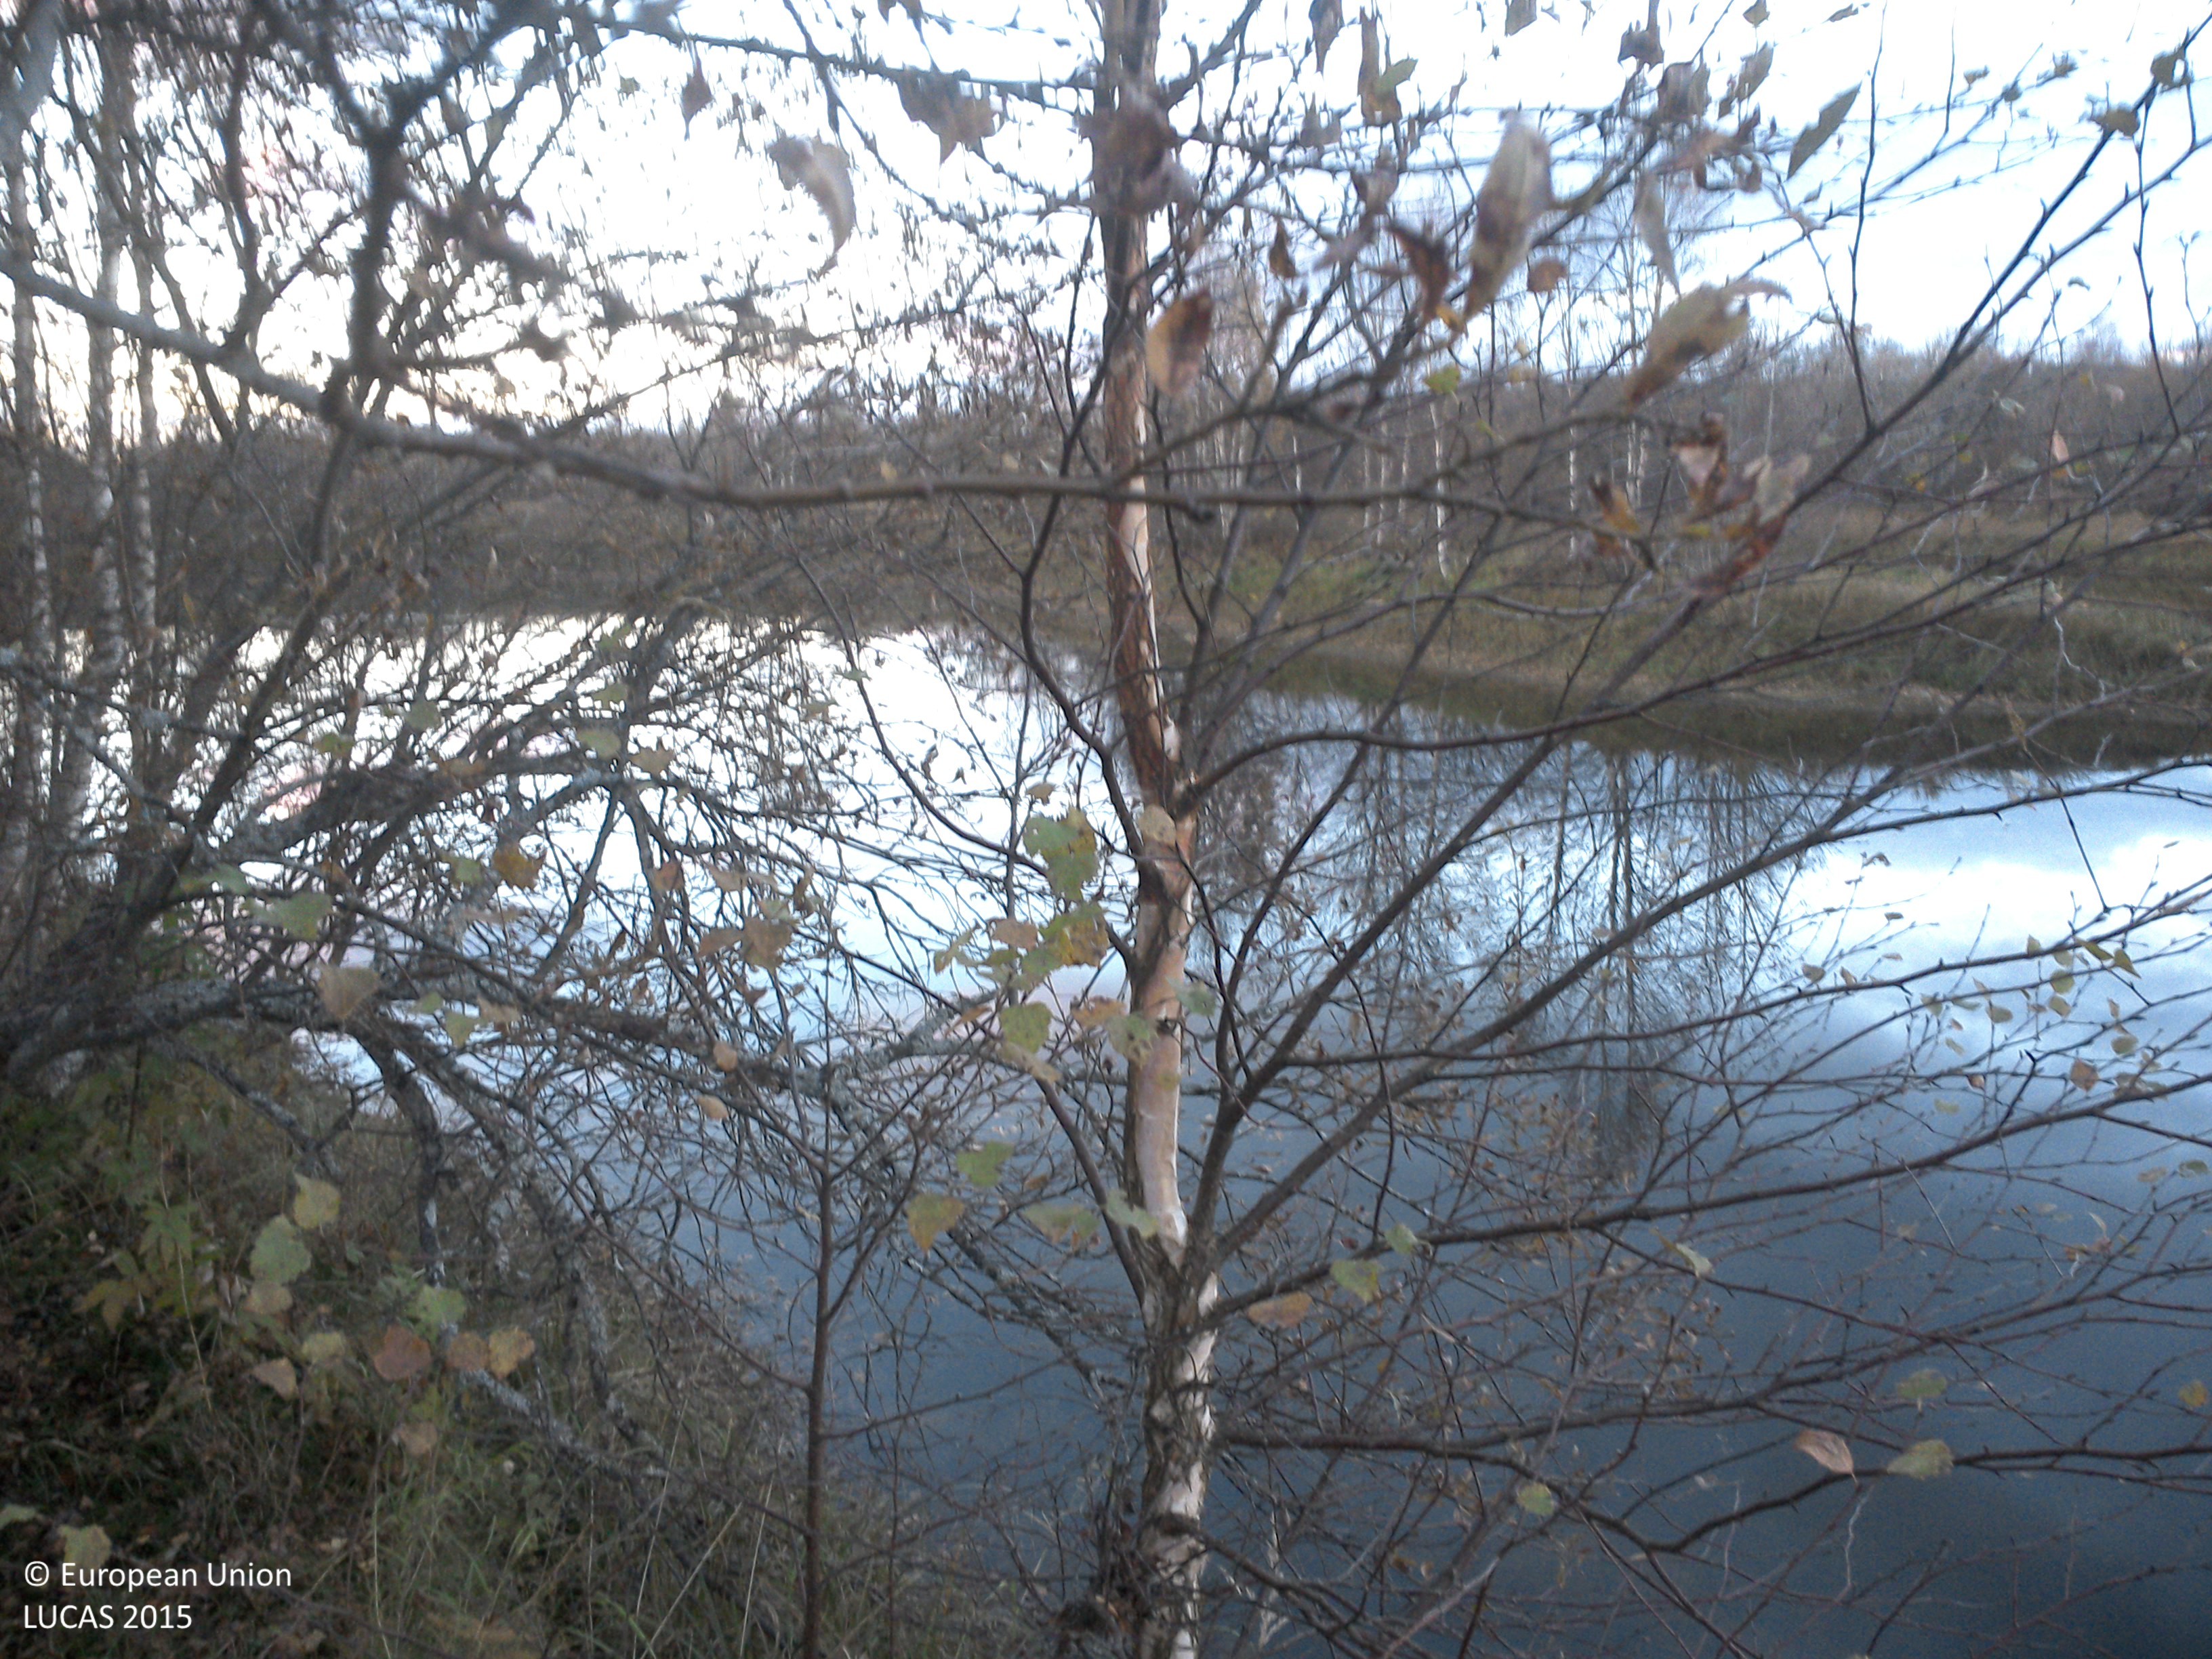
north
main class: Woodland
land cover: Broadleaved woodland
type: boreal forest
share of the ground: 25 - 50 %
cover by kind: herbaceous plants 60 %, broadleaved forest trees 40 %
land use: Semi-natural and natural areas not in use
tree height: > 5 m
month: October
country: SE
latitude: 63.8880
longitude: 19.8965
